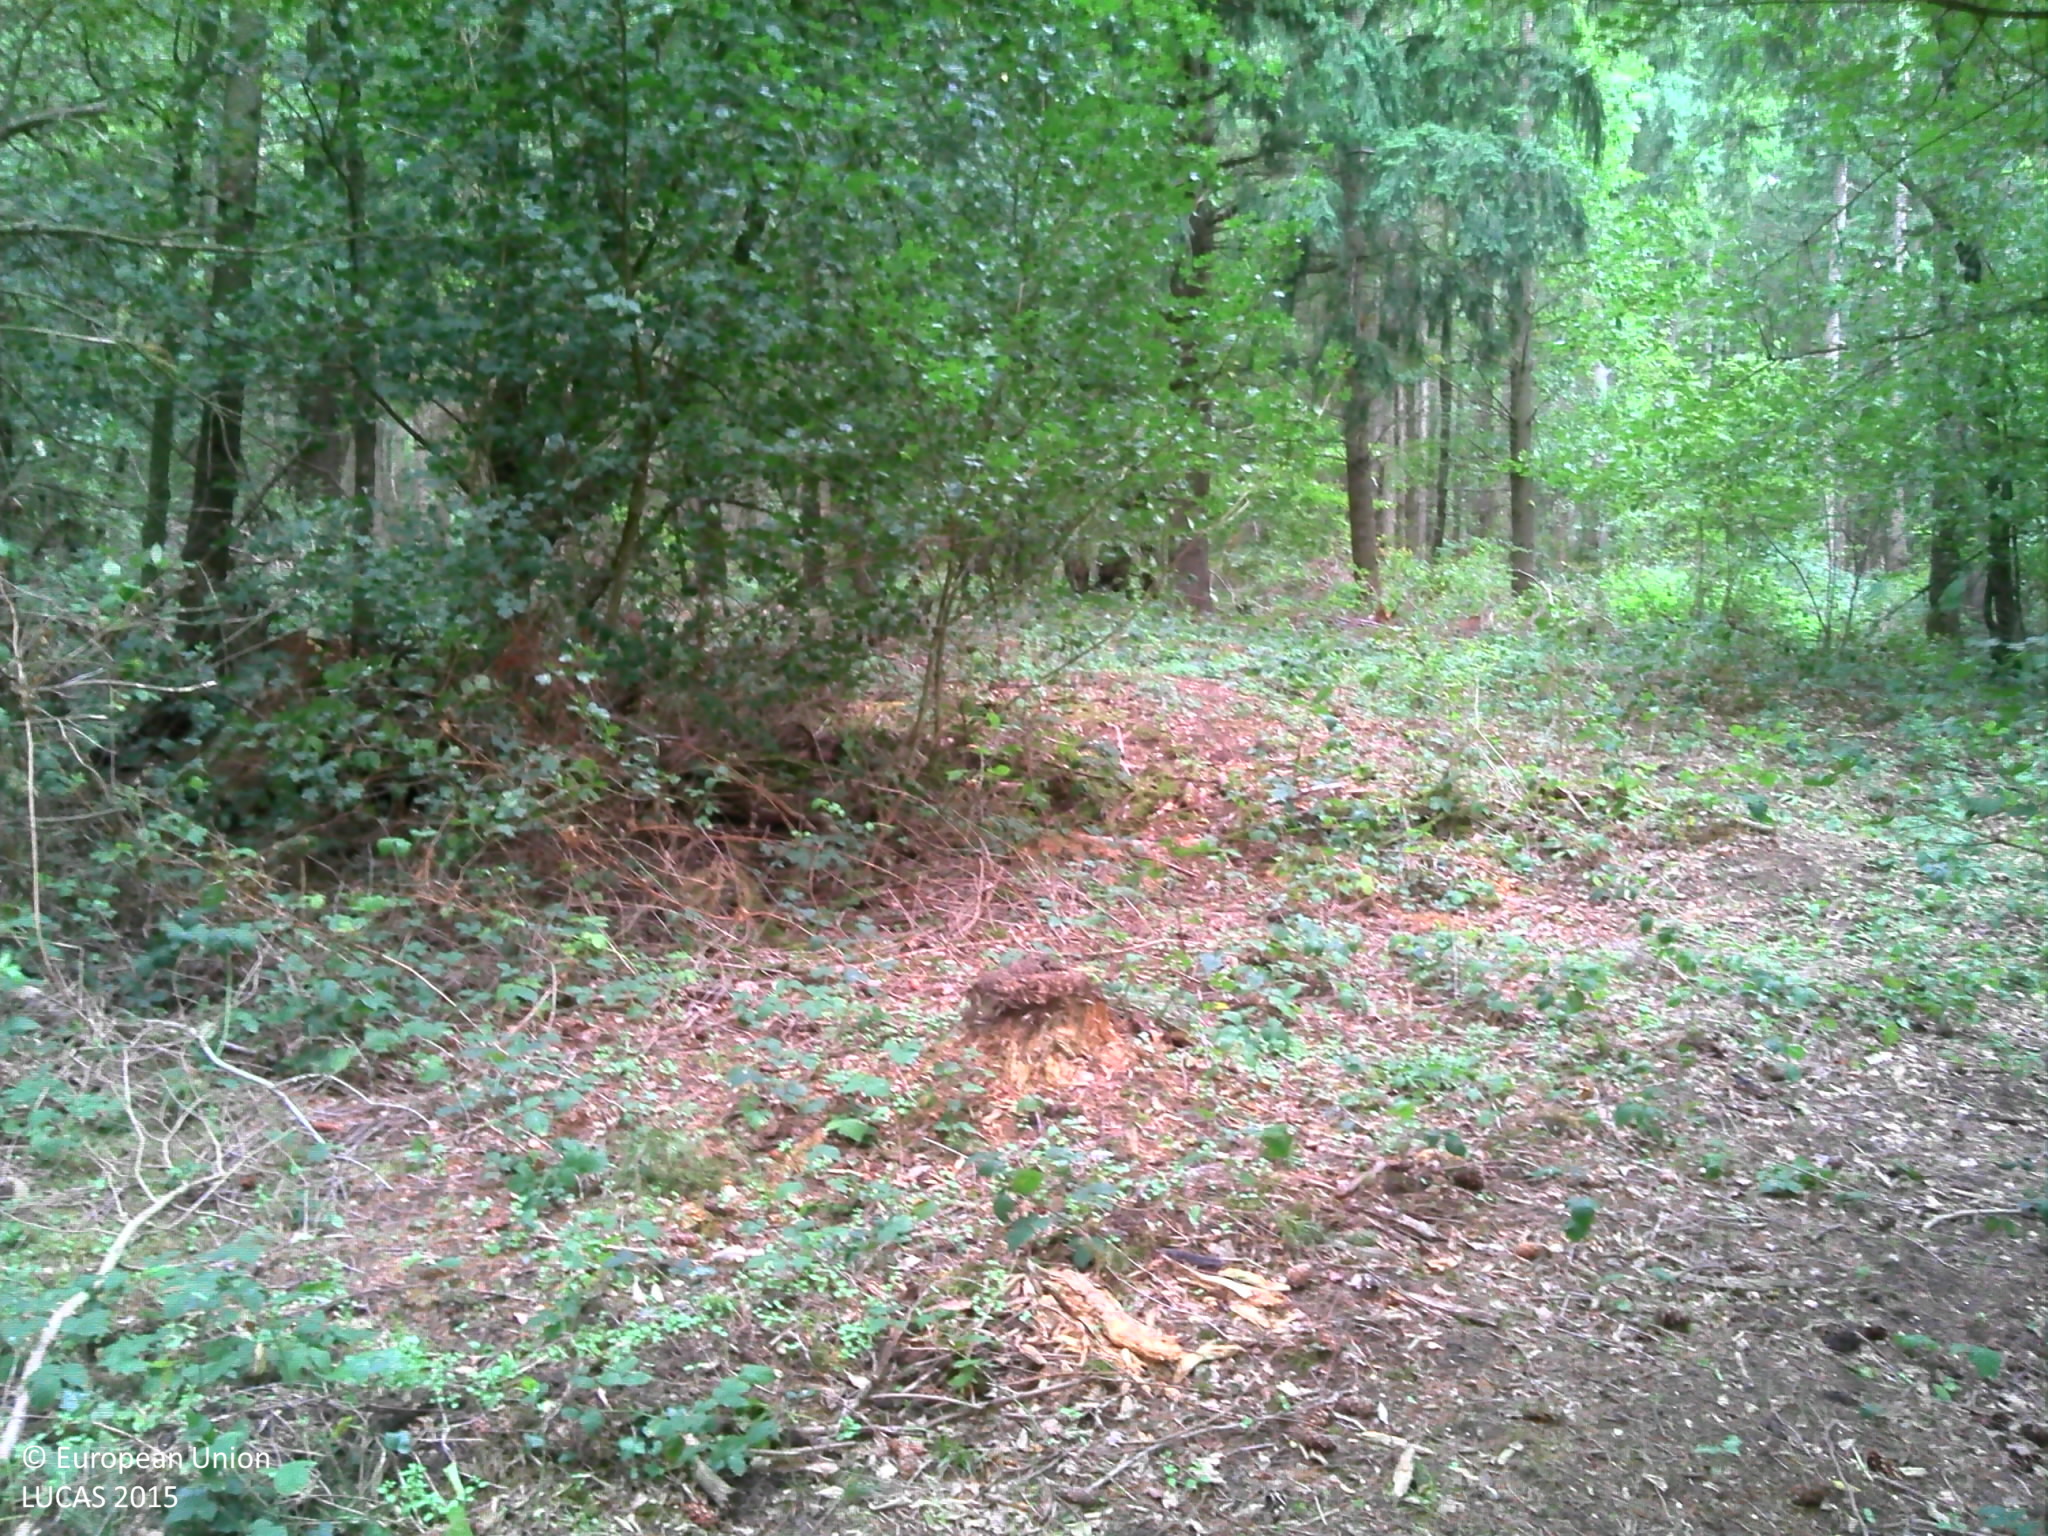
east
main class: Woodland
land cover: Other coniferous woodland
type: exotic forest
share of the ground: > 75 %
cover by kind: coniferous forest trees 85 %, broadleaved forest trees 5 %, herbaceous plants 5 %, lichens and mosses 5 %
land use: Forestry
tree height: > 5 m
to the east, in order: Other coniferous woodland
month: September
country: FR
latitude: 48.2498
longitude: 3.8410
